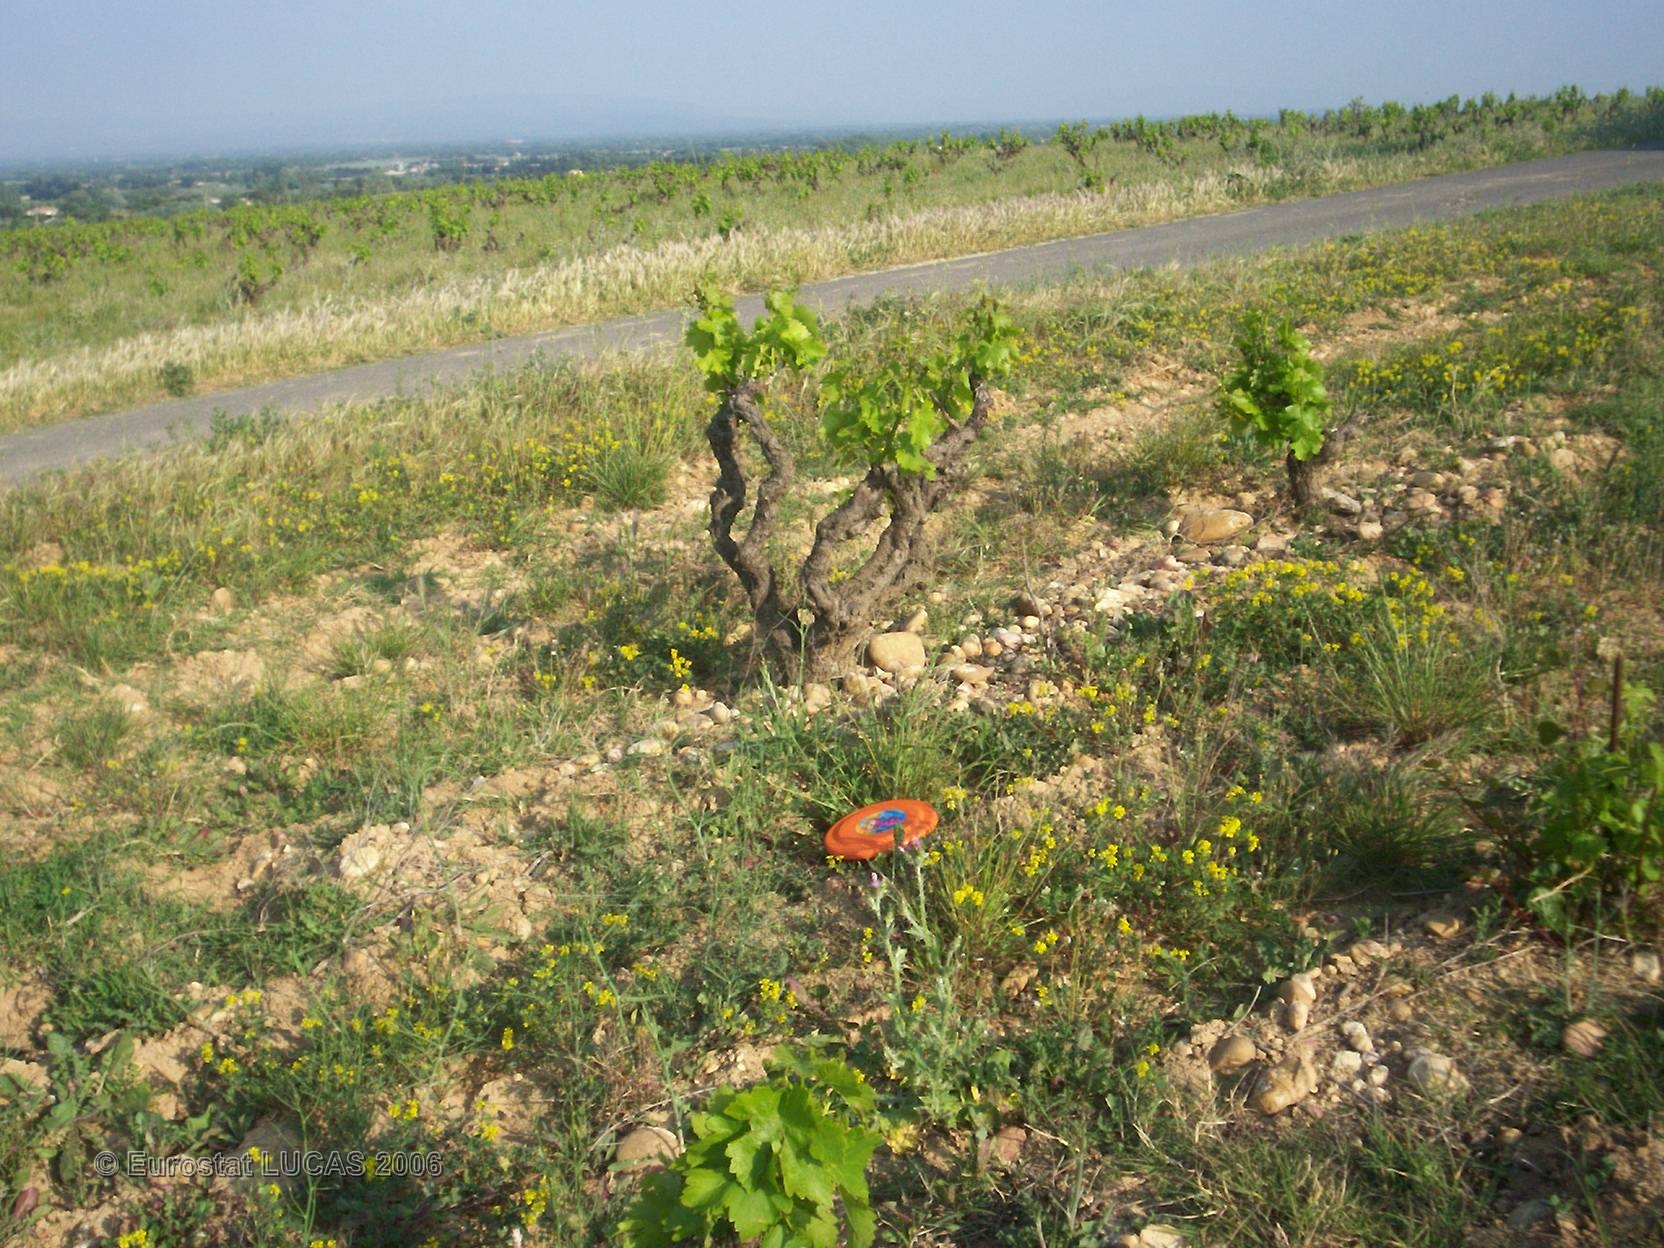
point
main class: Cropland
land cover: Vineyards
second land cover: Grassland without tree/shrub cover
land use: Agriculture (excluding fallow land and kitchen gardens)
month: May
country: FR
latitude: 44.0614
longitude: 4.8774
